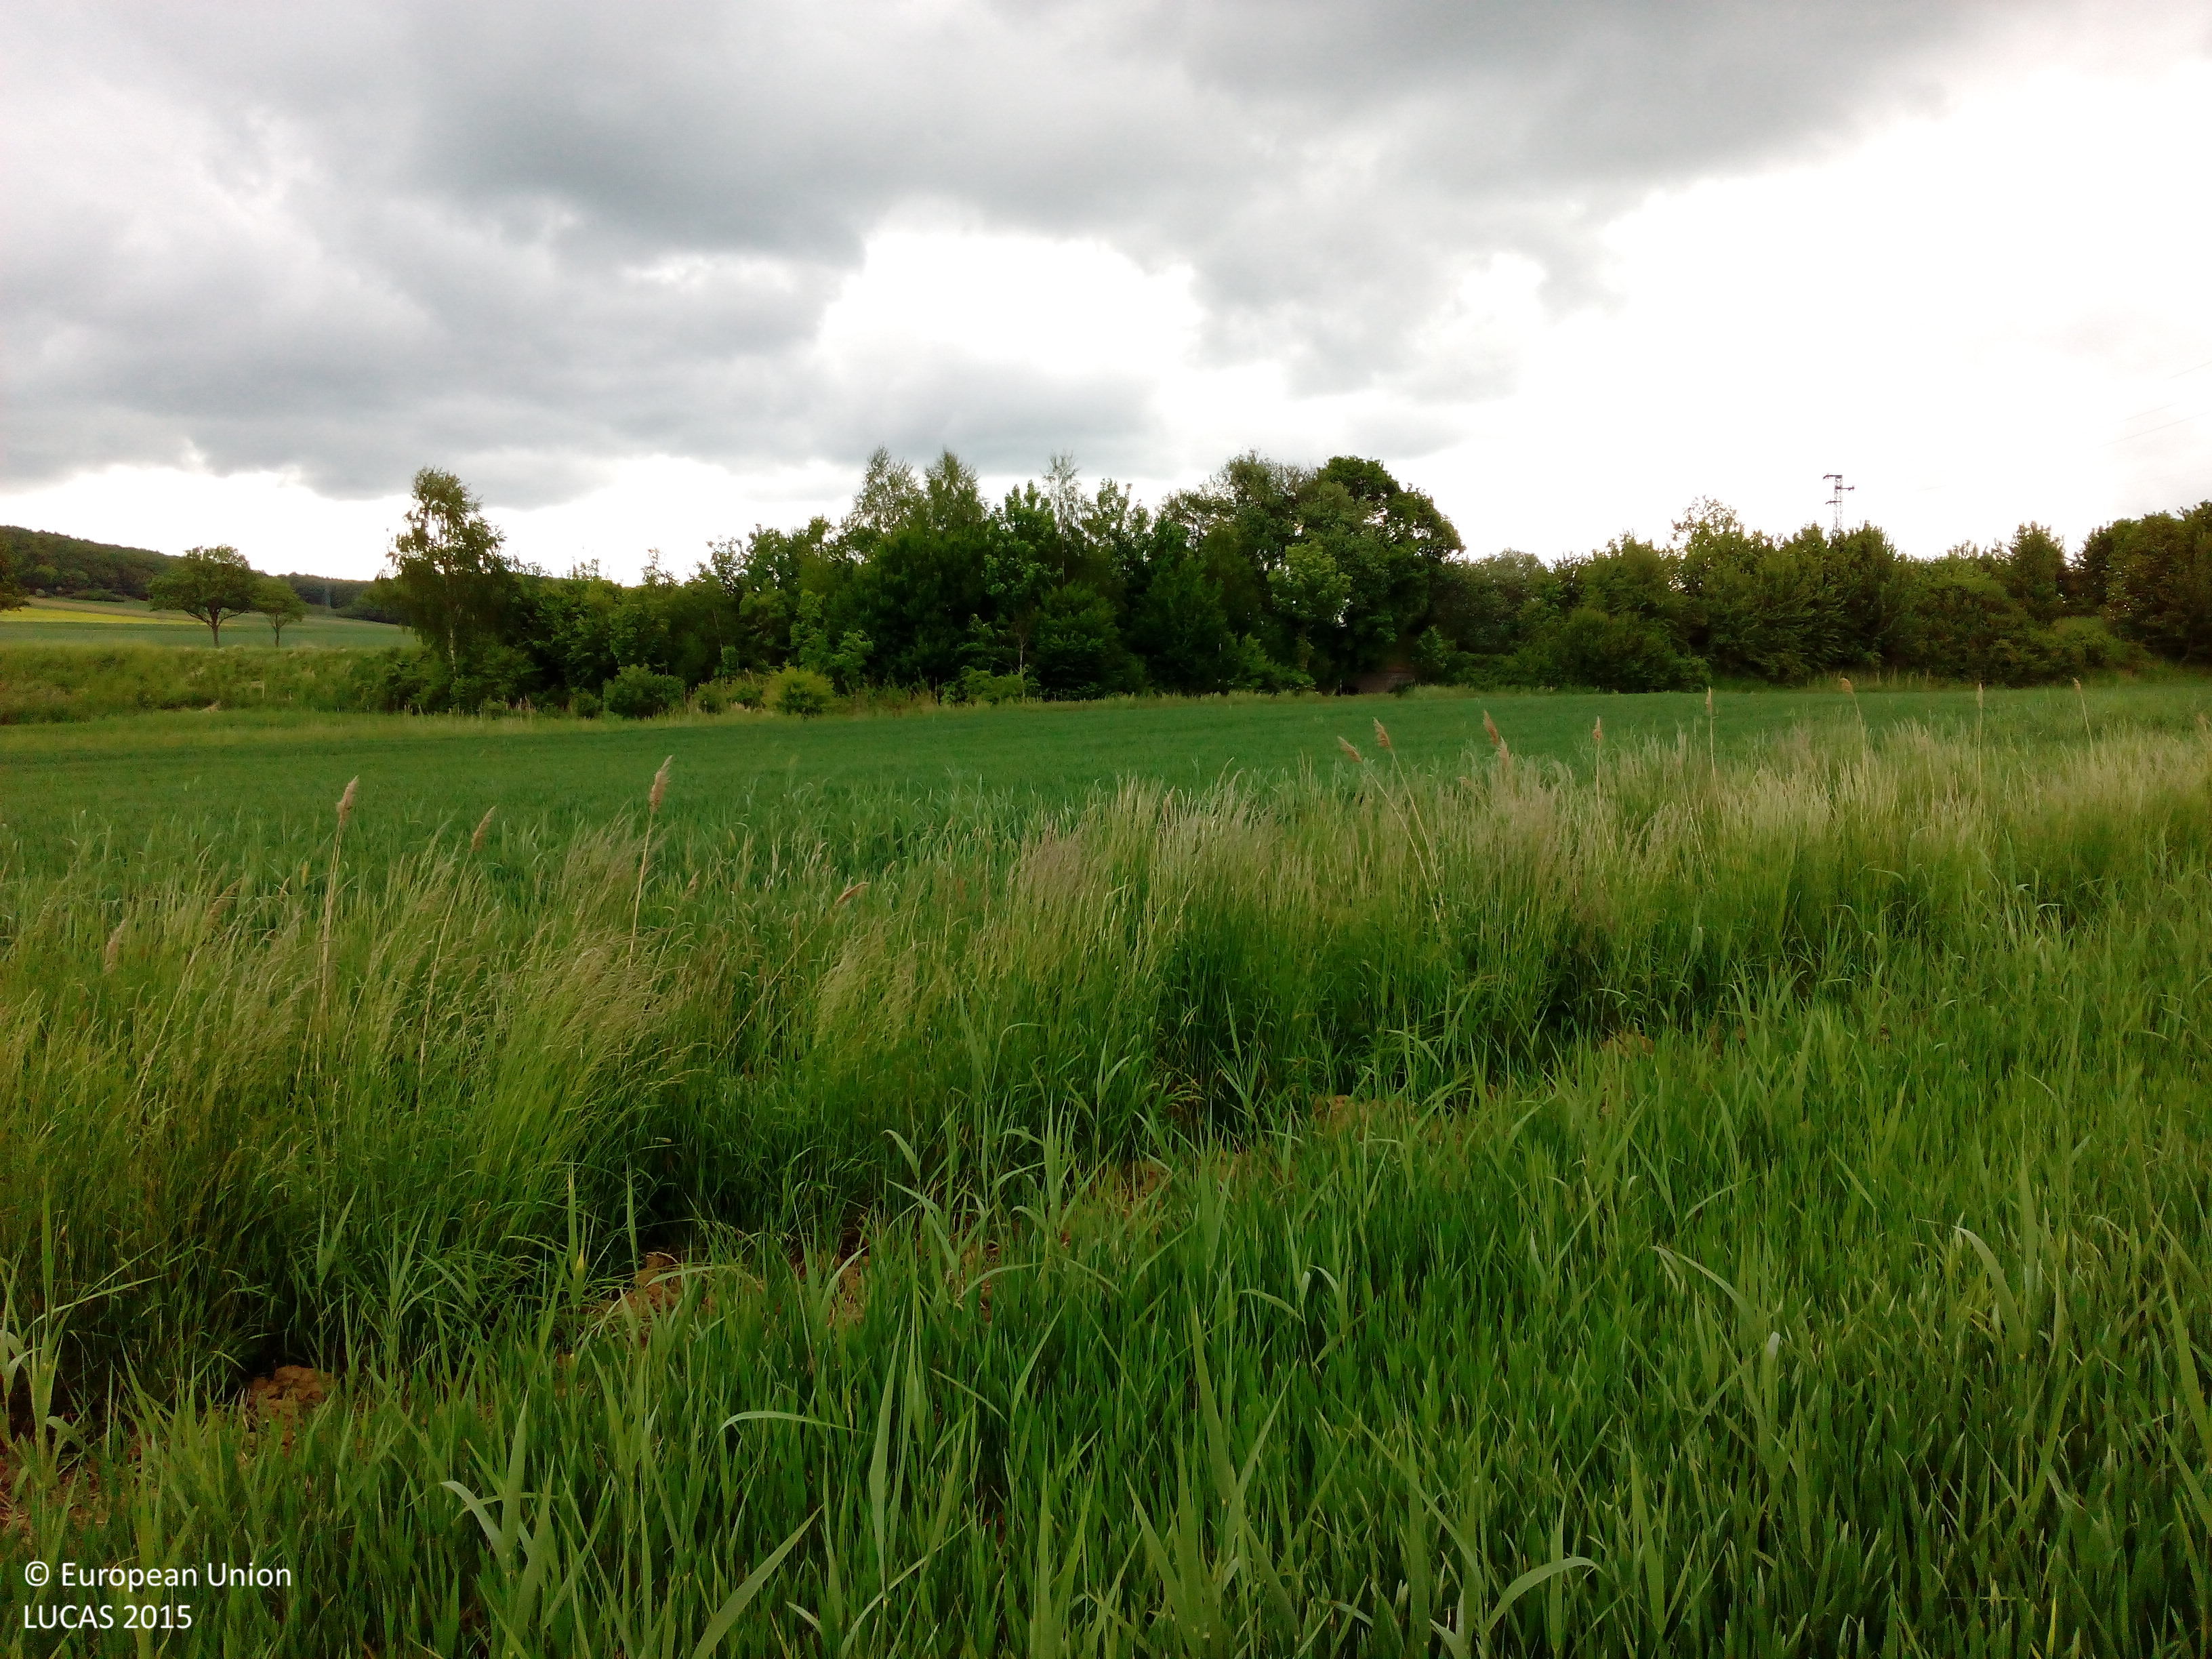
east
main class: Cropland
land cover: Common wheat
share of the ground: > 75 %
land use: Agriculture (excluding fallow land and kitchen gardens)
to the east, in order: Common wheat; Grass margins; Ditches and canals; Grass margins; Triticale; Grass margins; Inland fresh running water; Grass margins; Broadleaved woodland; Artificial constructions; Grass margins; Shrubland with sparse tree cover; Shruby margins; Ditches and canals; Grass margins; Triticale; Rape and turnip rape
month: May
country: DE
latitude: 52.0718
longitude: 9.8687
